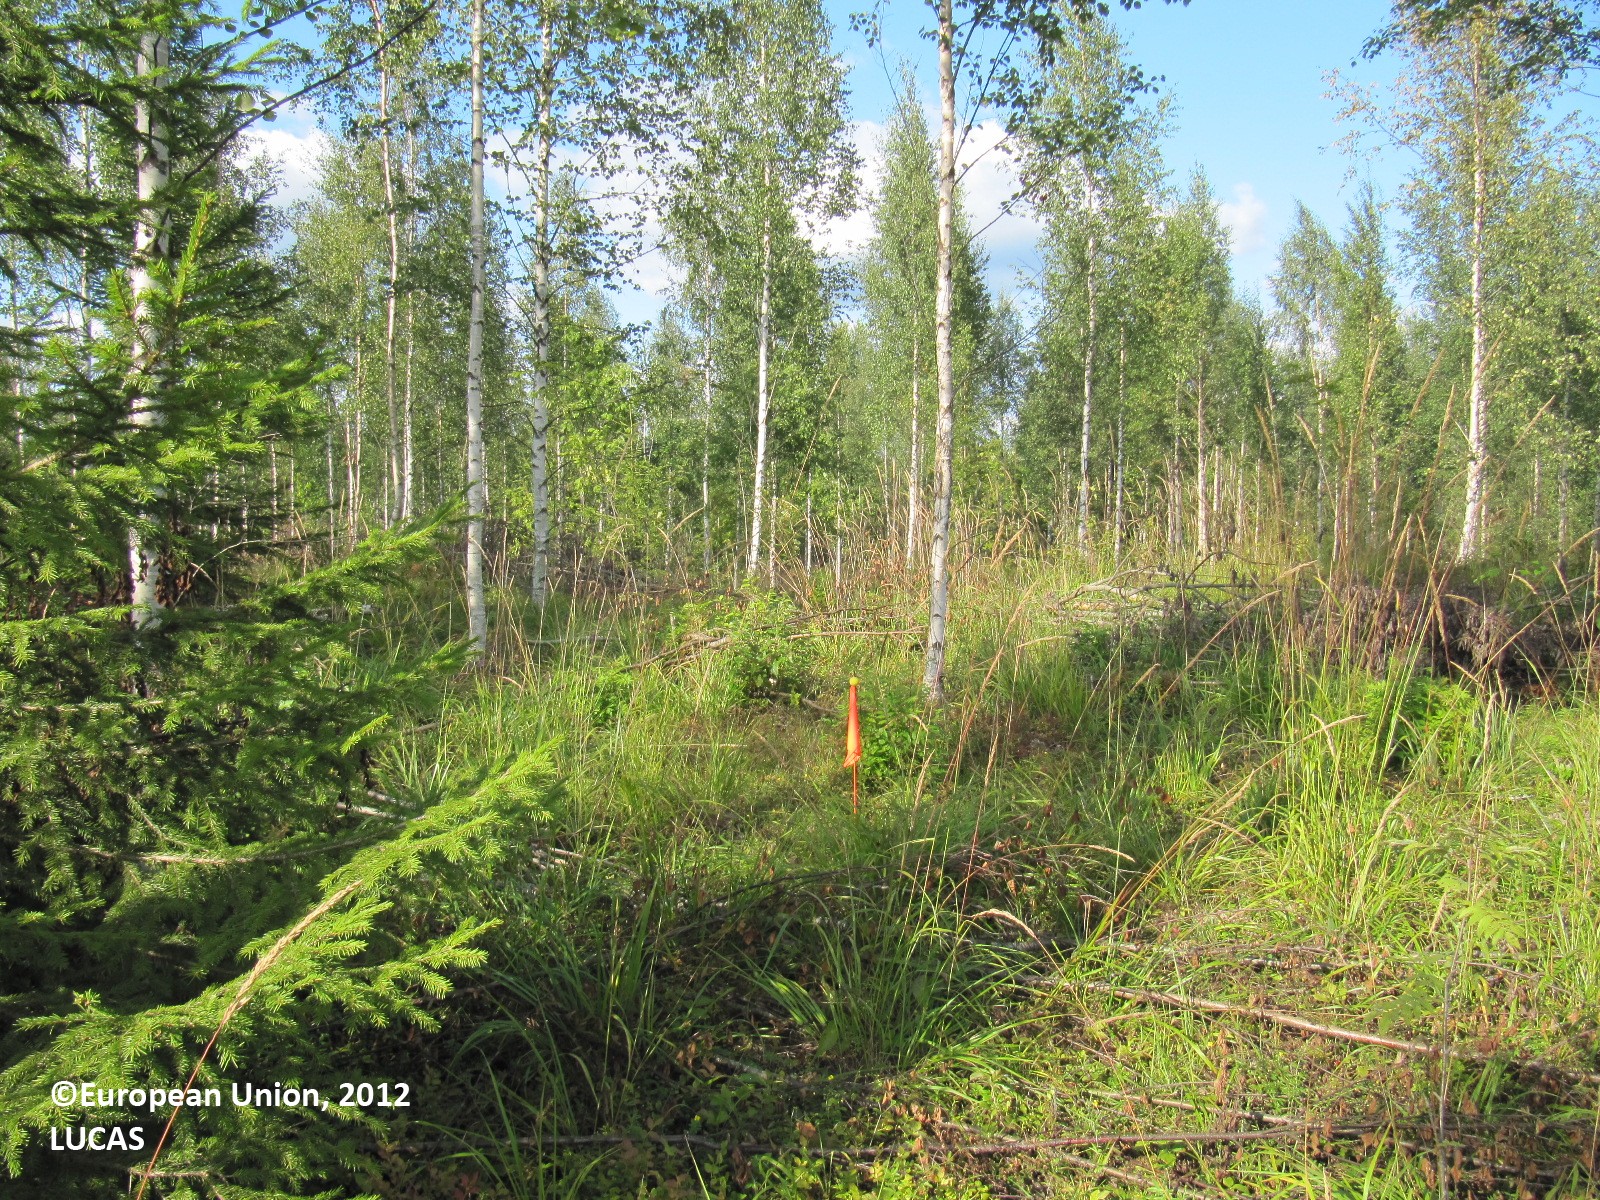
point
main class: Woodland
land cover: Other mixed woodland
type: boreal forest
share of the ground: 25 - 50 %
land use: Forestry
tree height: > 5 m
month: August
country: FI
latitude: 60.5953
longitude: 24.5496
